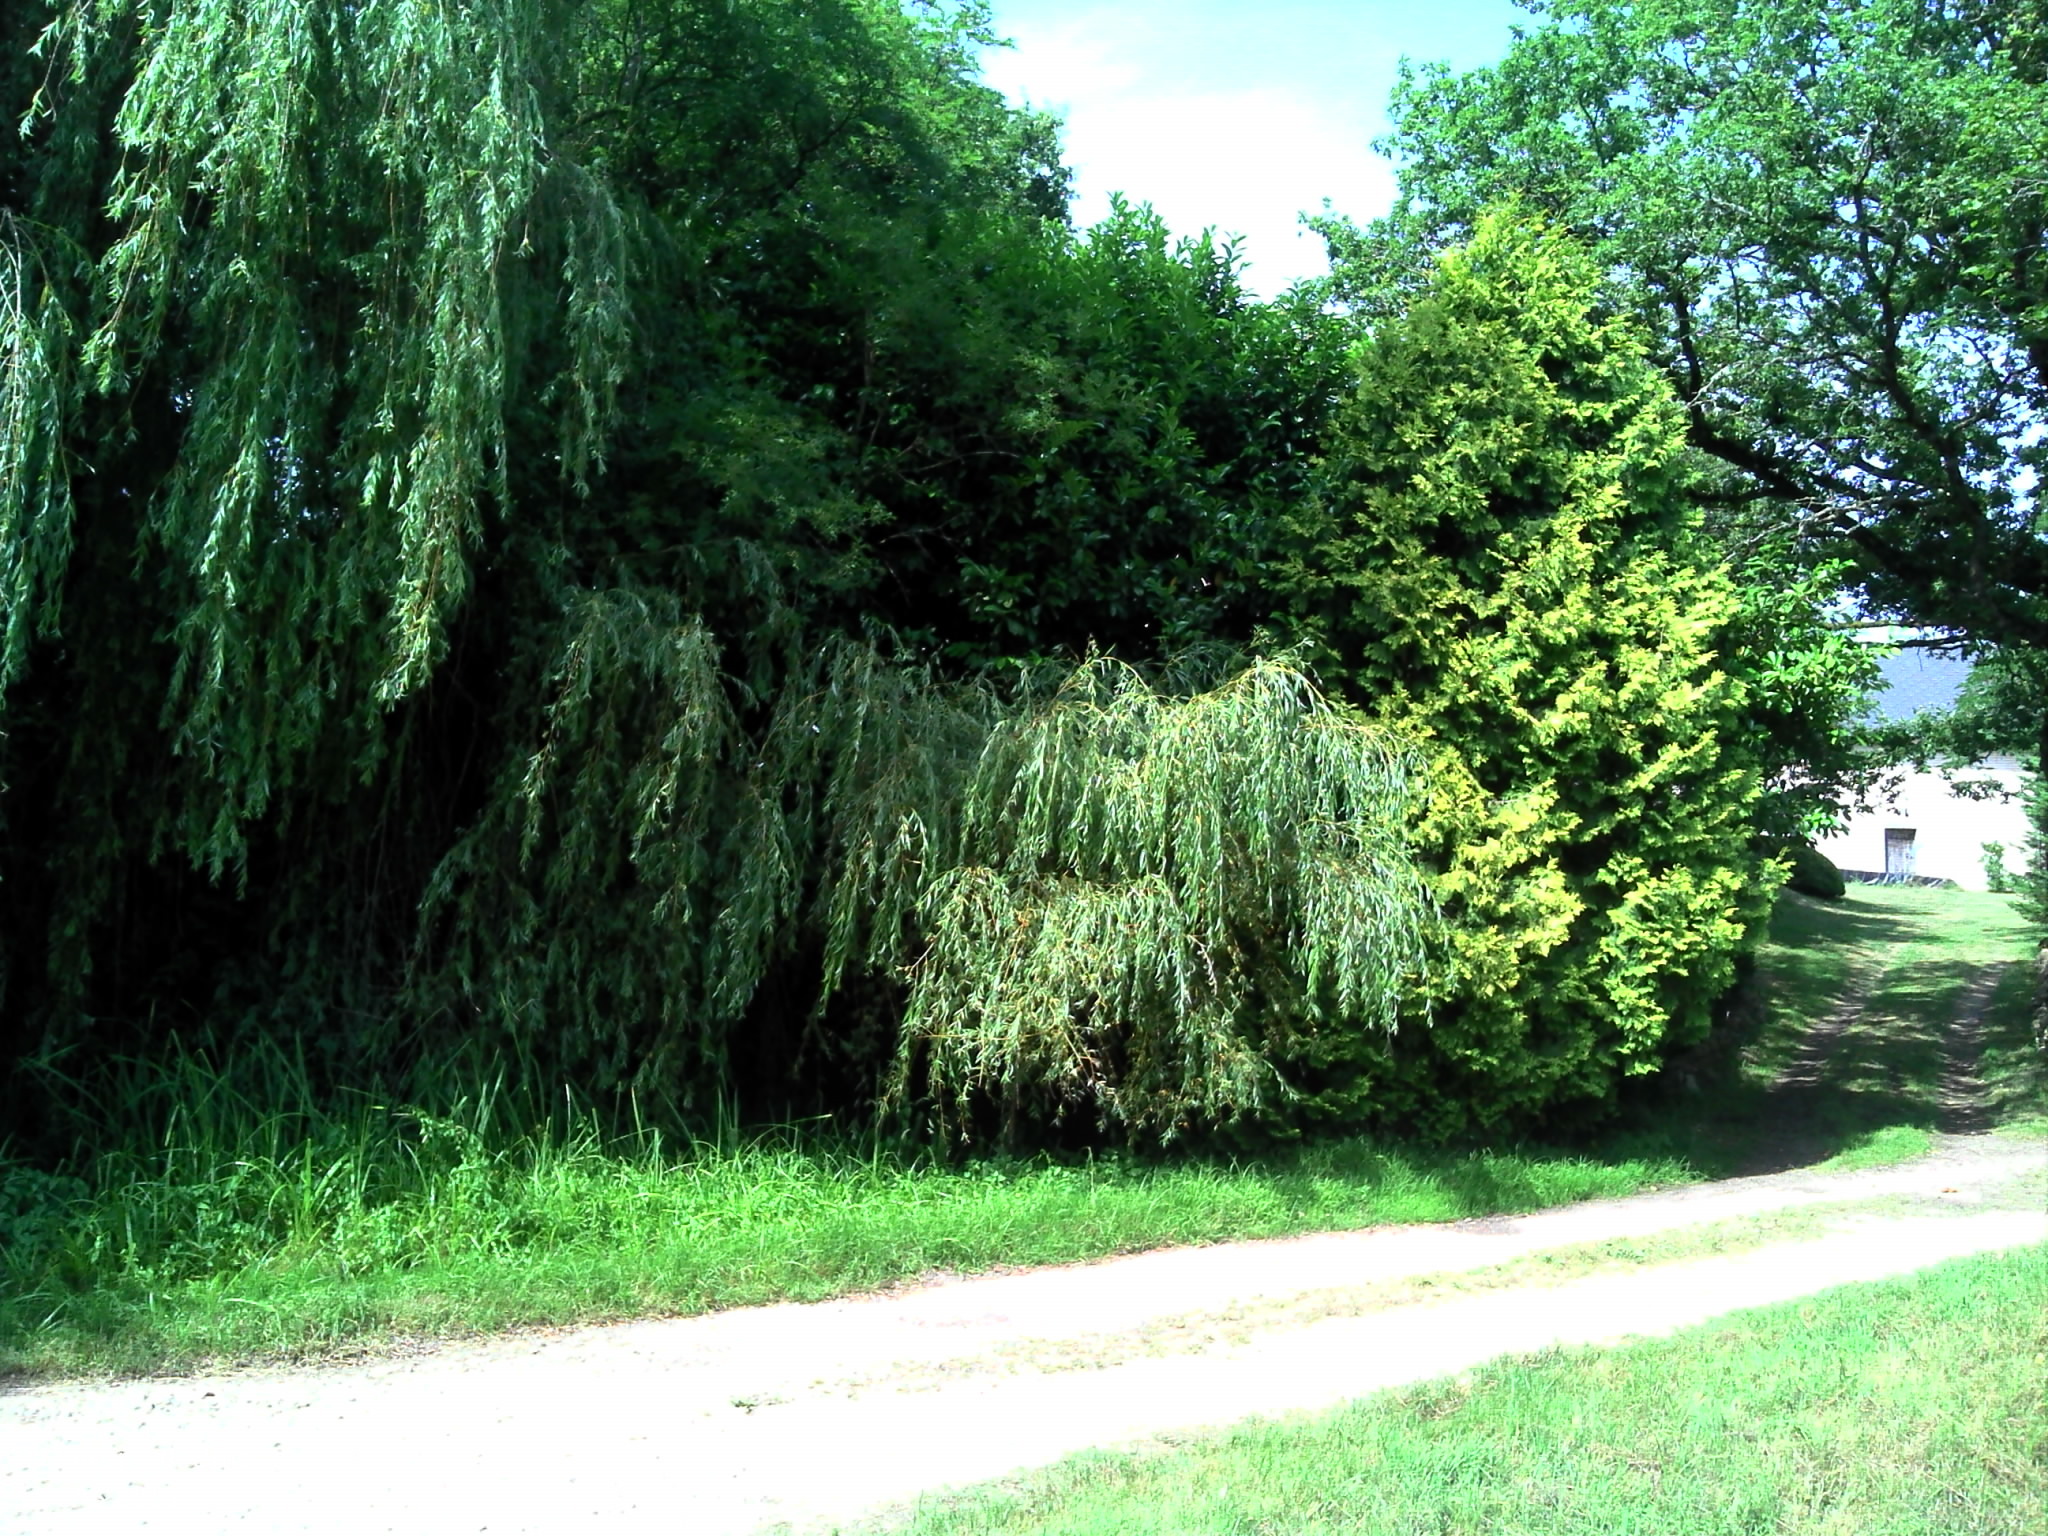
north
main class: Grassland
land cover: Grassland without tree/shrub cover
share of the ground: > 75 %
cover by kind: herbaceous plants 100 %
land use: Agriculture (excluding fallow land and kitchen gardens)
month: July
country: FR
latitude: 47.0407
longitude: 3.5354
